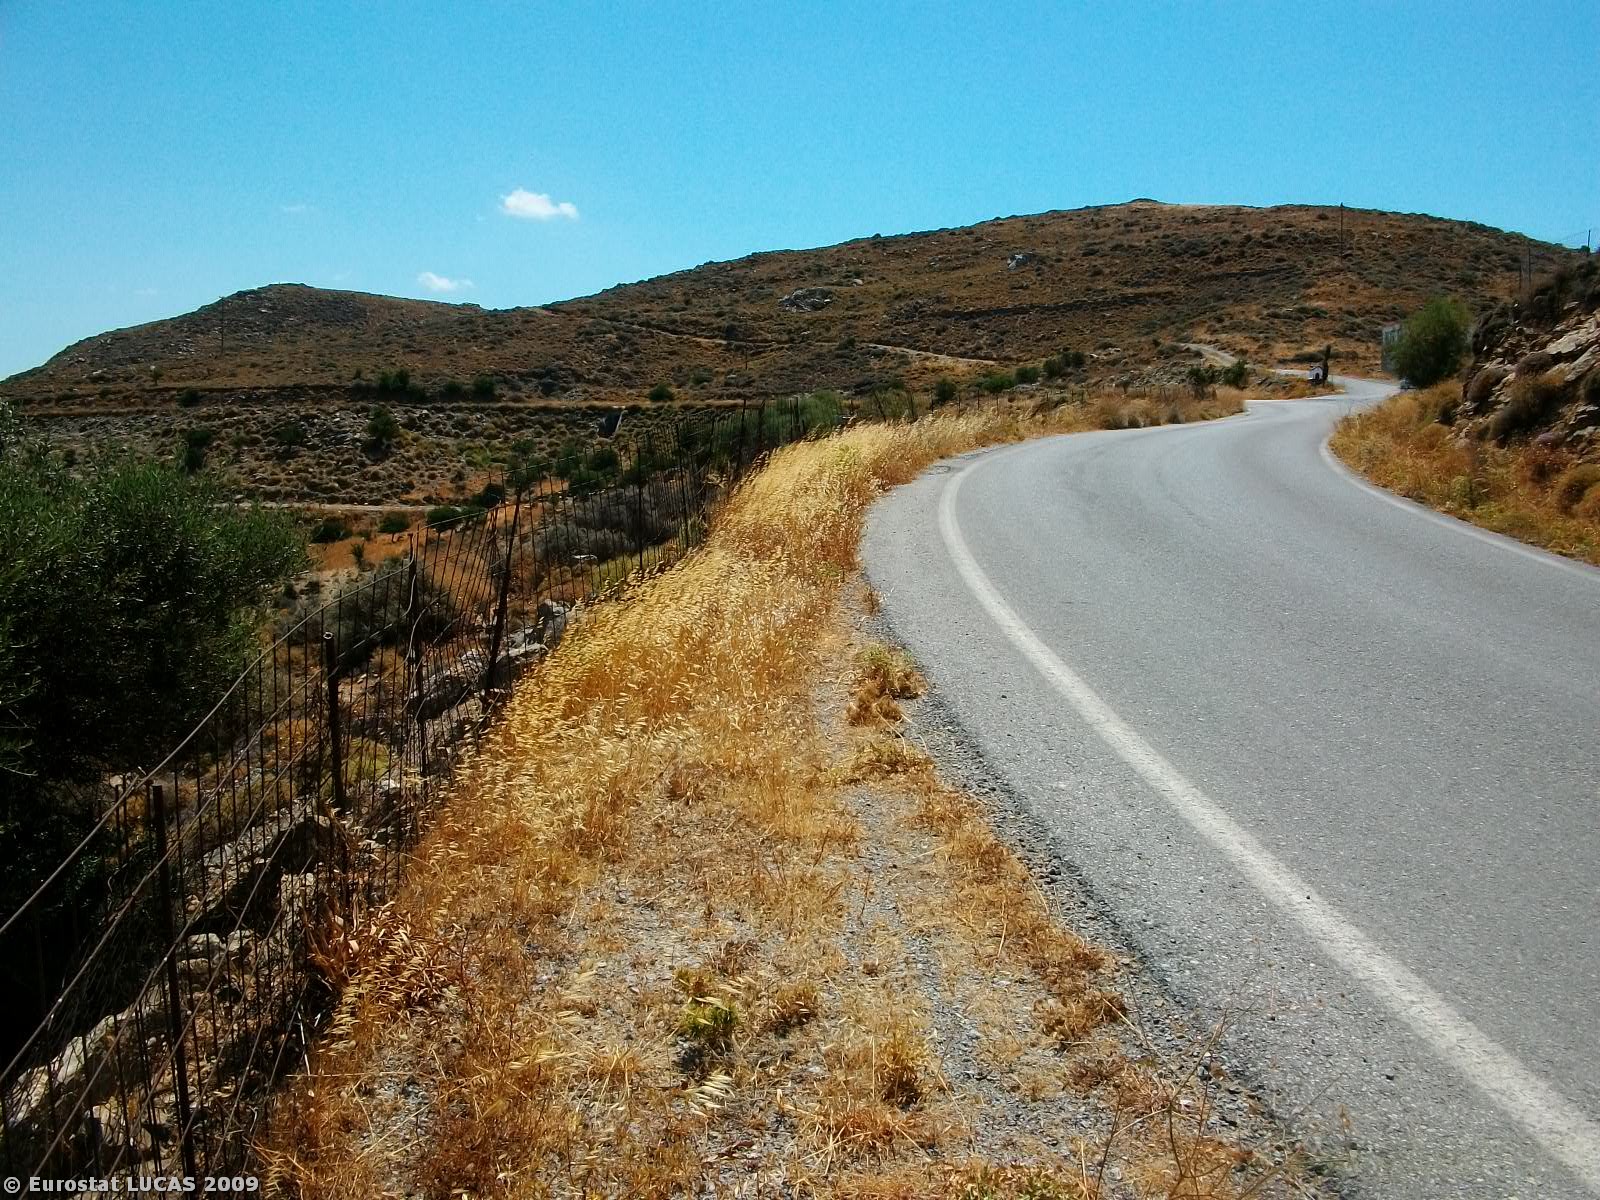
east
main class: Shrubland
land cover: Shrubland without tree cover
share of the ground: > 75 %
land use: Agriculture (excluding fallow land and kitchen gardens)
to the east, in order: Shrubland without tree cover; Tracks; Shrubland with sparse tree cover; Fences; Paved roads, cycling and walking lanes
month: July
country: GR
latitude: 34.9763
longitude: 24.9355
